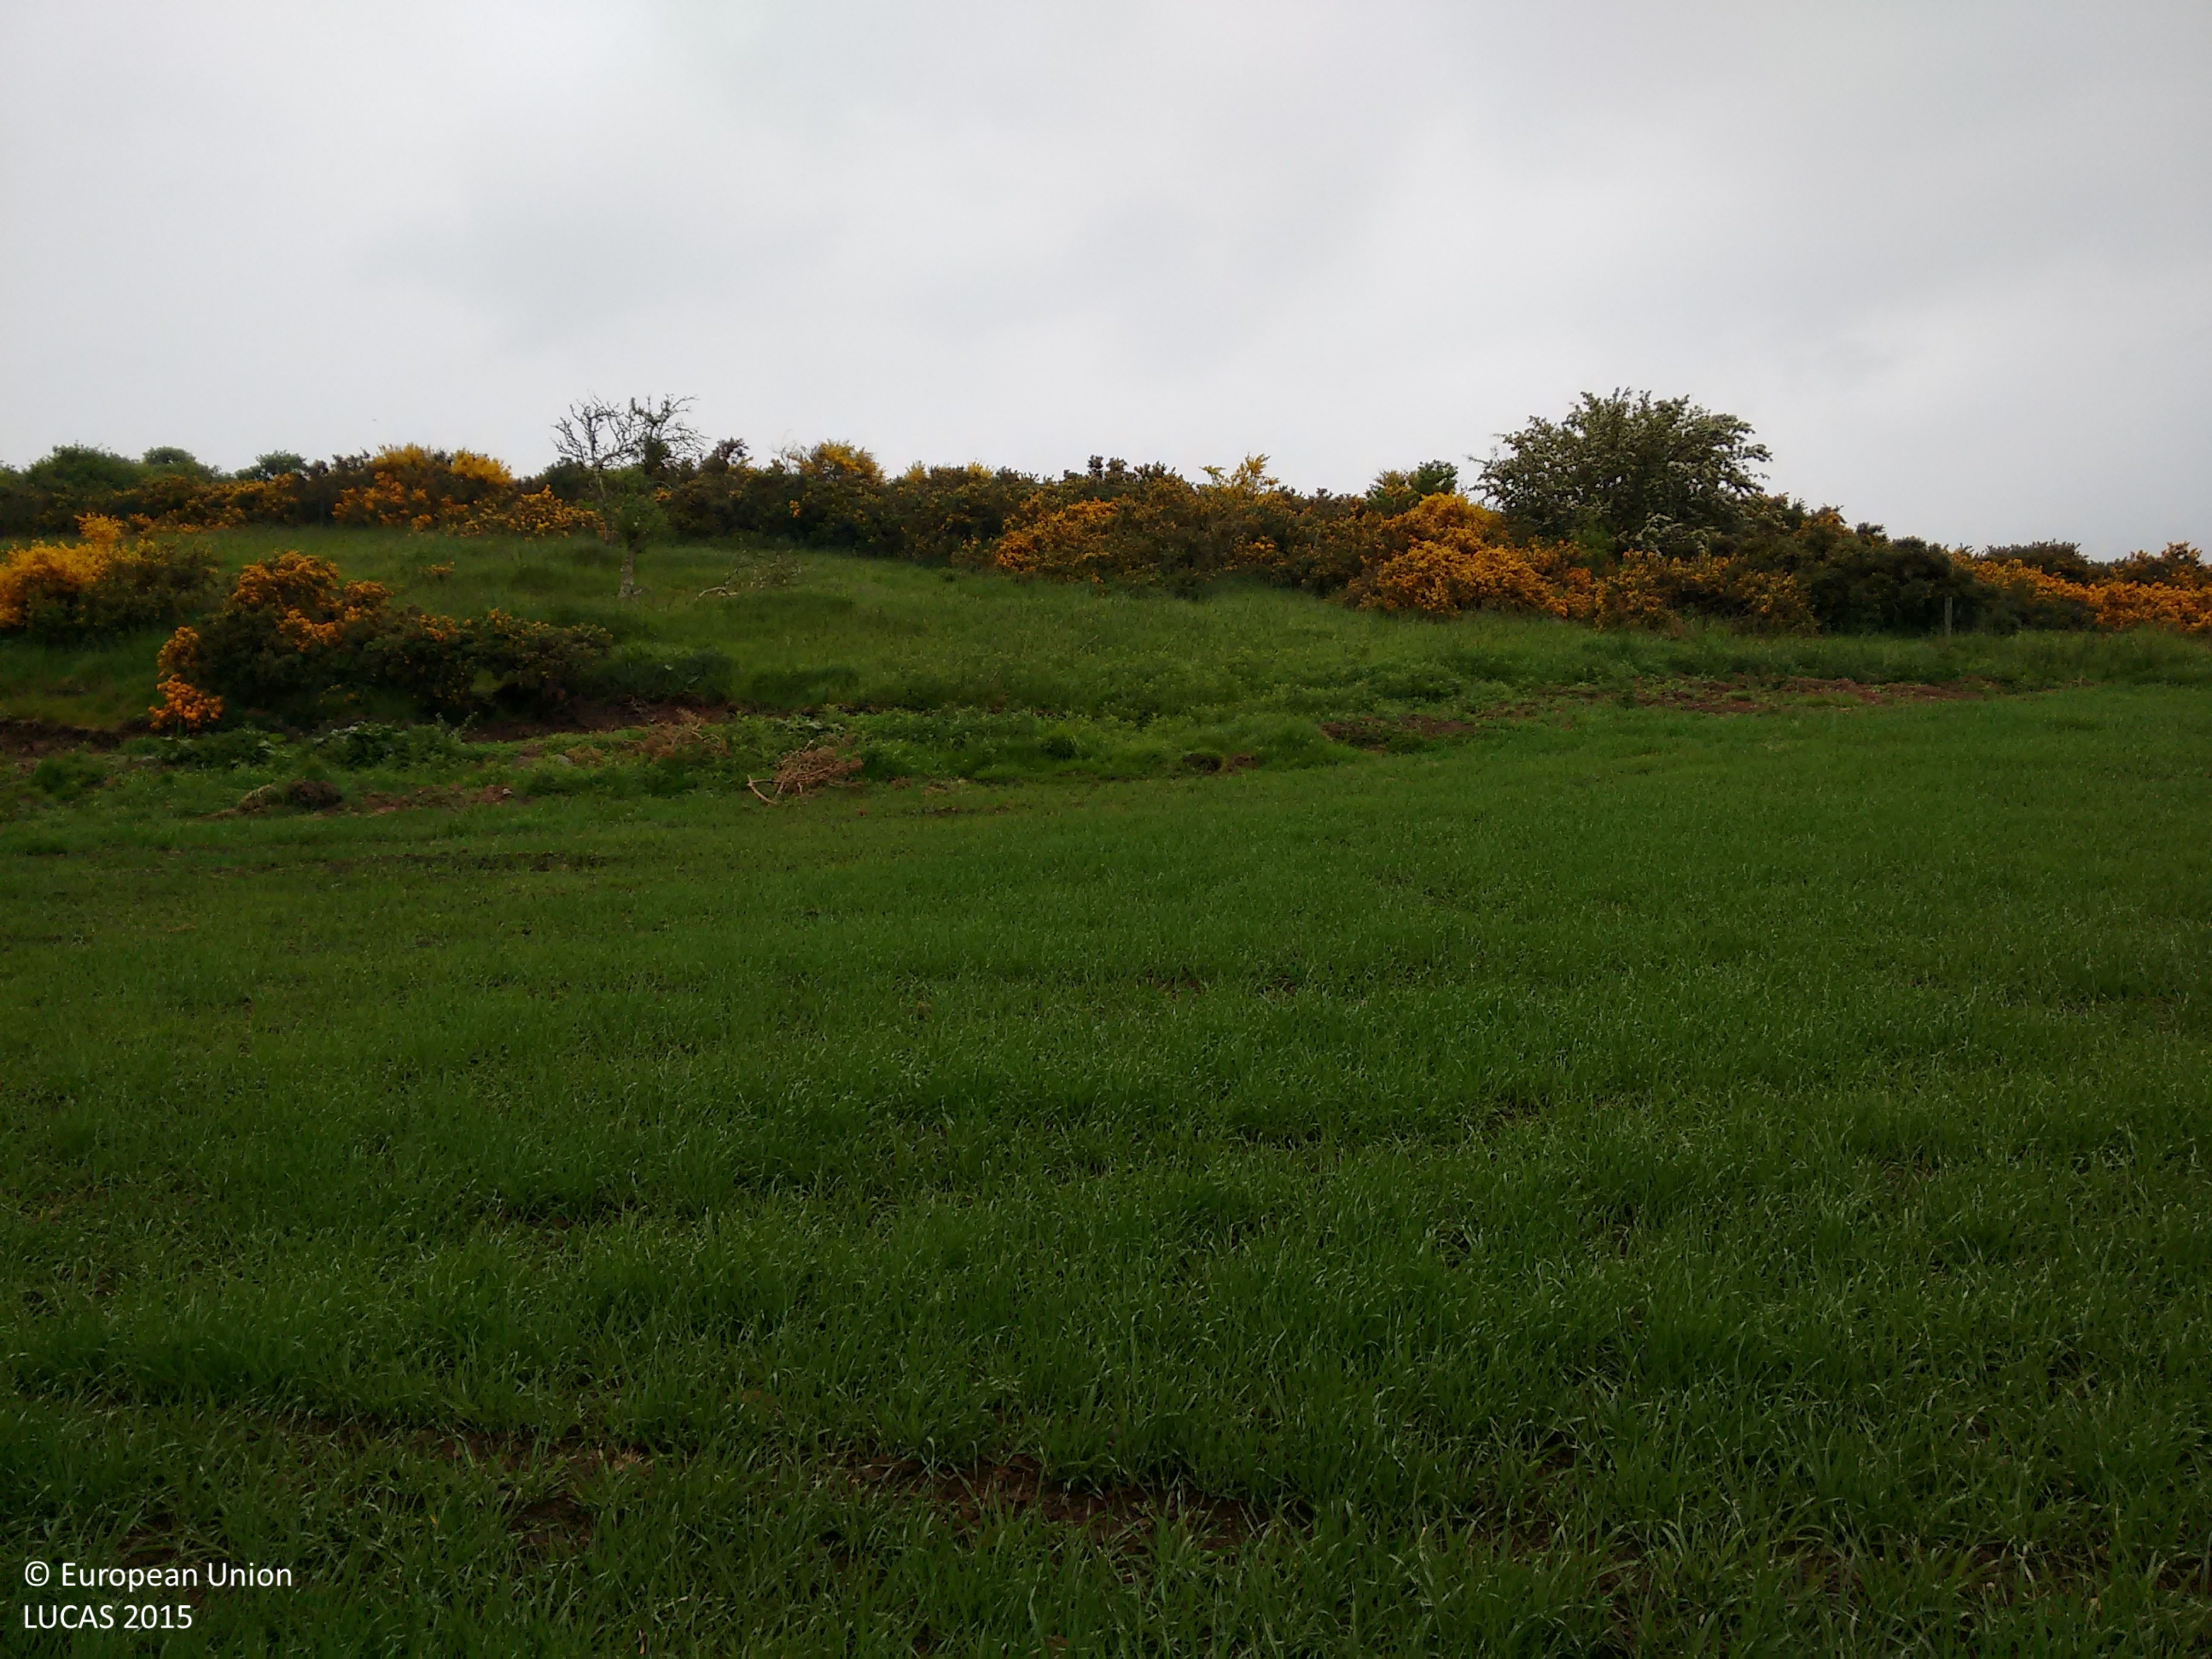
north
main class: Cropland
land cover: Barley
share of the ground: > 75 %
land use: Agriculture (excluding fallow land and kitchen gardens)
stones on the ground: < 10 %
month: June
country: GB
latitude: 56.3334
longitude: -3.4511
